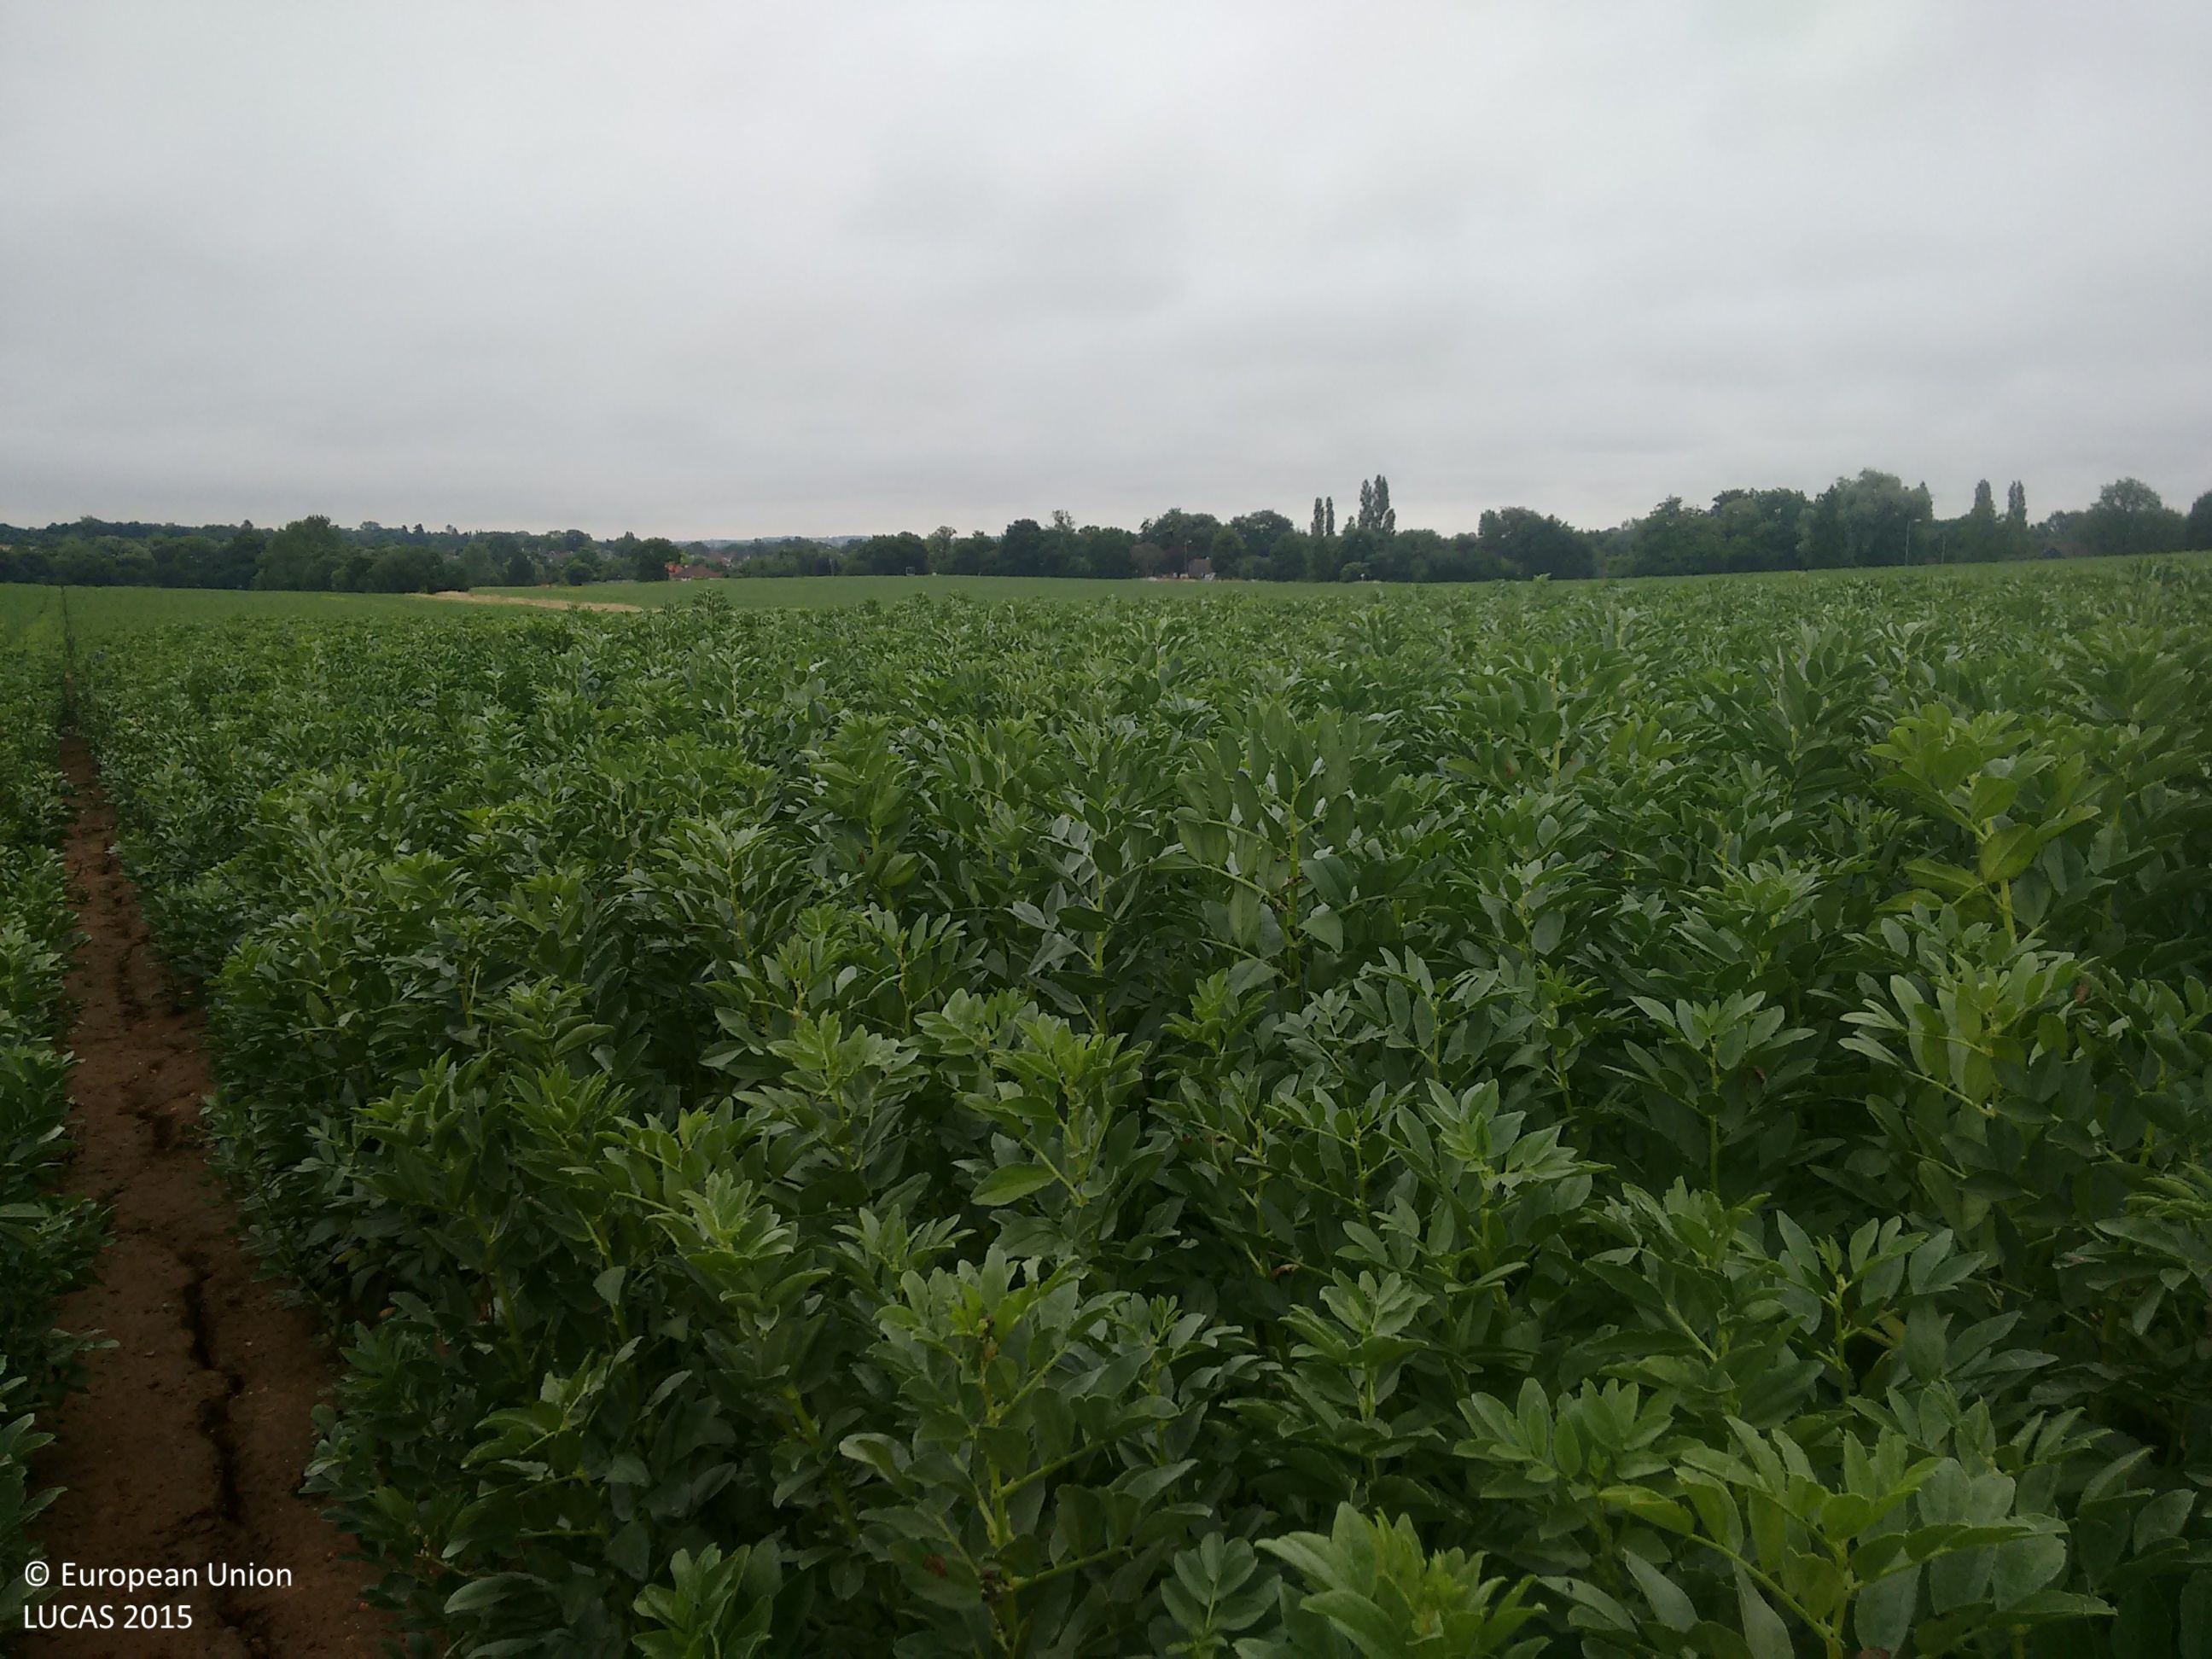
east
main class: Cropland
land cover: Dry pulses
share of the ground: > 75 %
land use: Agriculture (excluding fallow land and kitchen gardens)
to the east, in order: Dry pulses
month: July
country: GB
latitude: 51.6582
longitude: 0.3577
